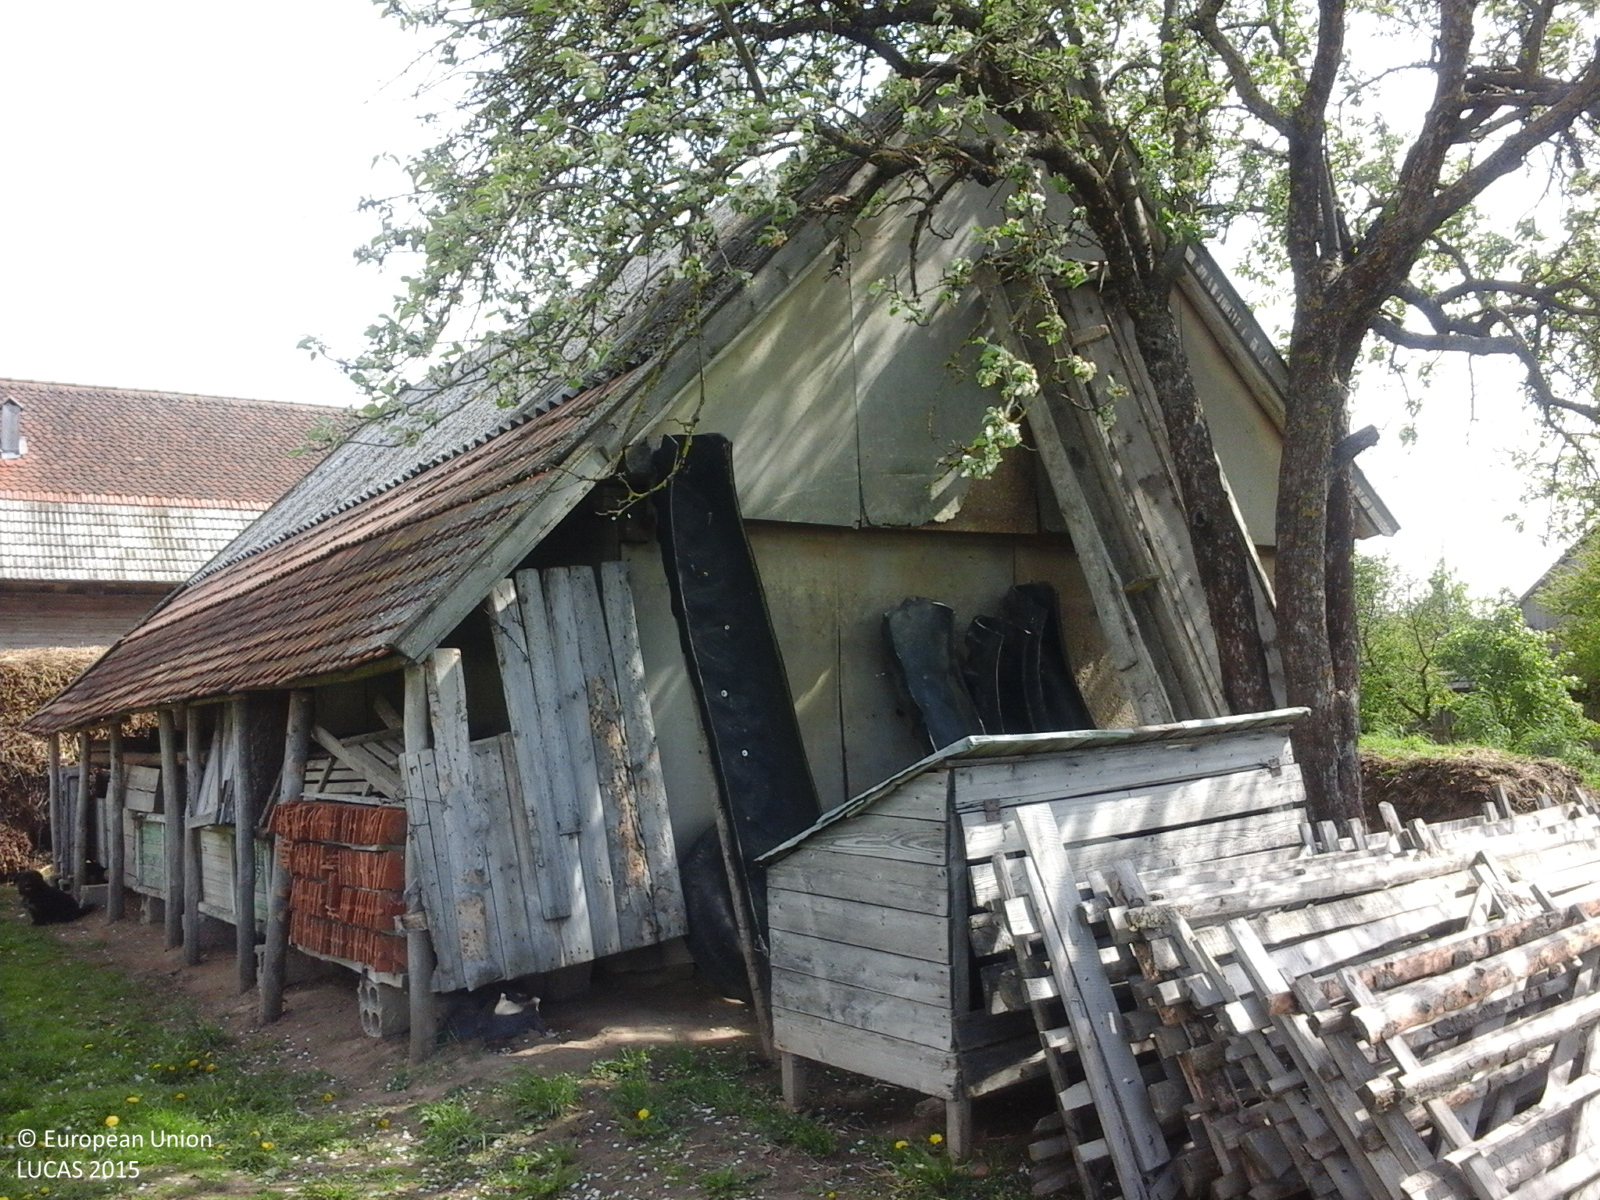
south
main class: Cropland
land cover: Other leguminous and mixtures for fodder
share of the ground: > 75 %
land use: Agriculture (excluding fallow land and kitchen gardens)
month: May
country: RO
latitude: 45.8631
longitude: 26.0506
